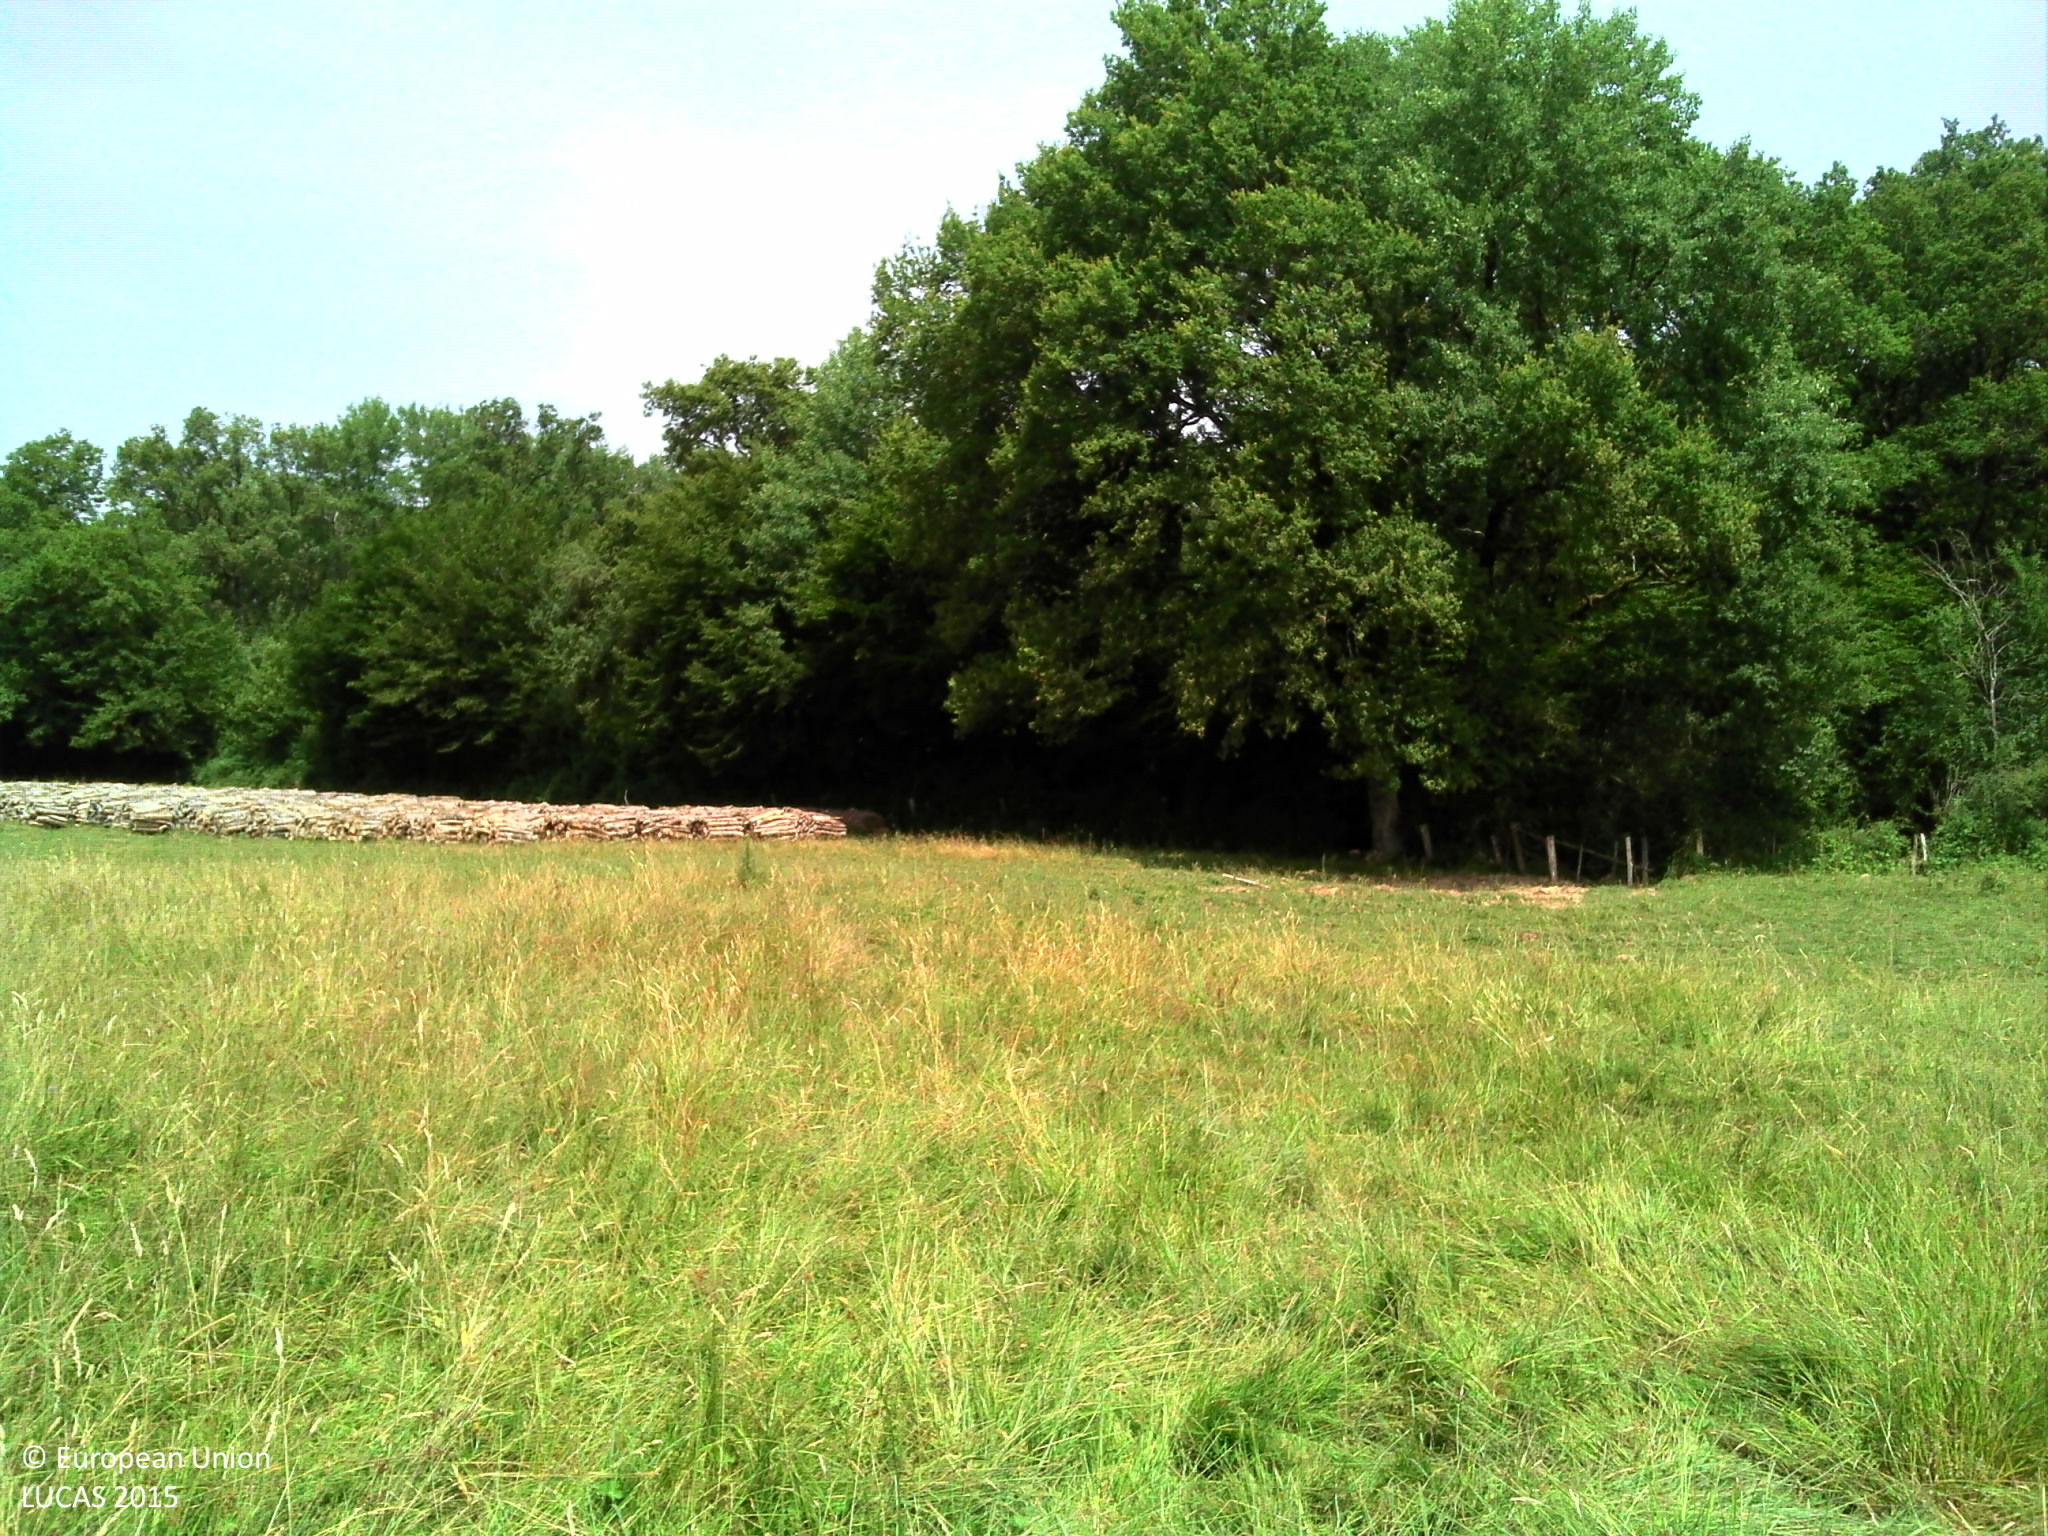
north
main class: Grassland
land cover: Grassland without tree/shrub cover
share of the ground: > 75 %
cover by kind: herbaceous plants 100 %
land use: Agriculture (excluding fallow land and kitchen gardens)
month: July
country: FR
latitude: 47.0766
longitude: 3.5310
